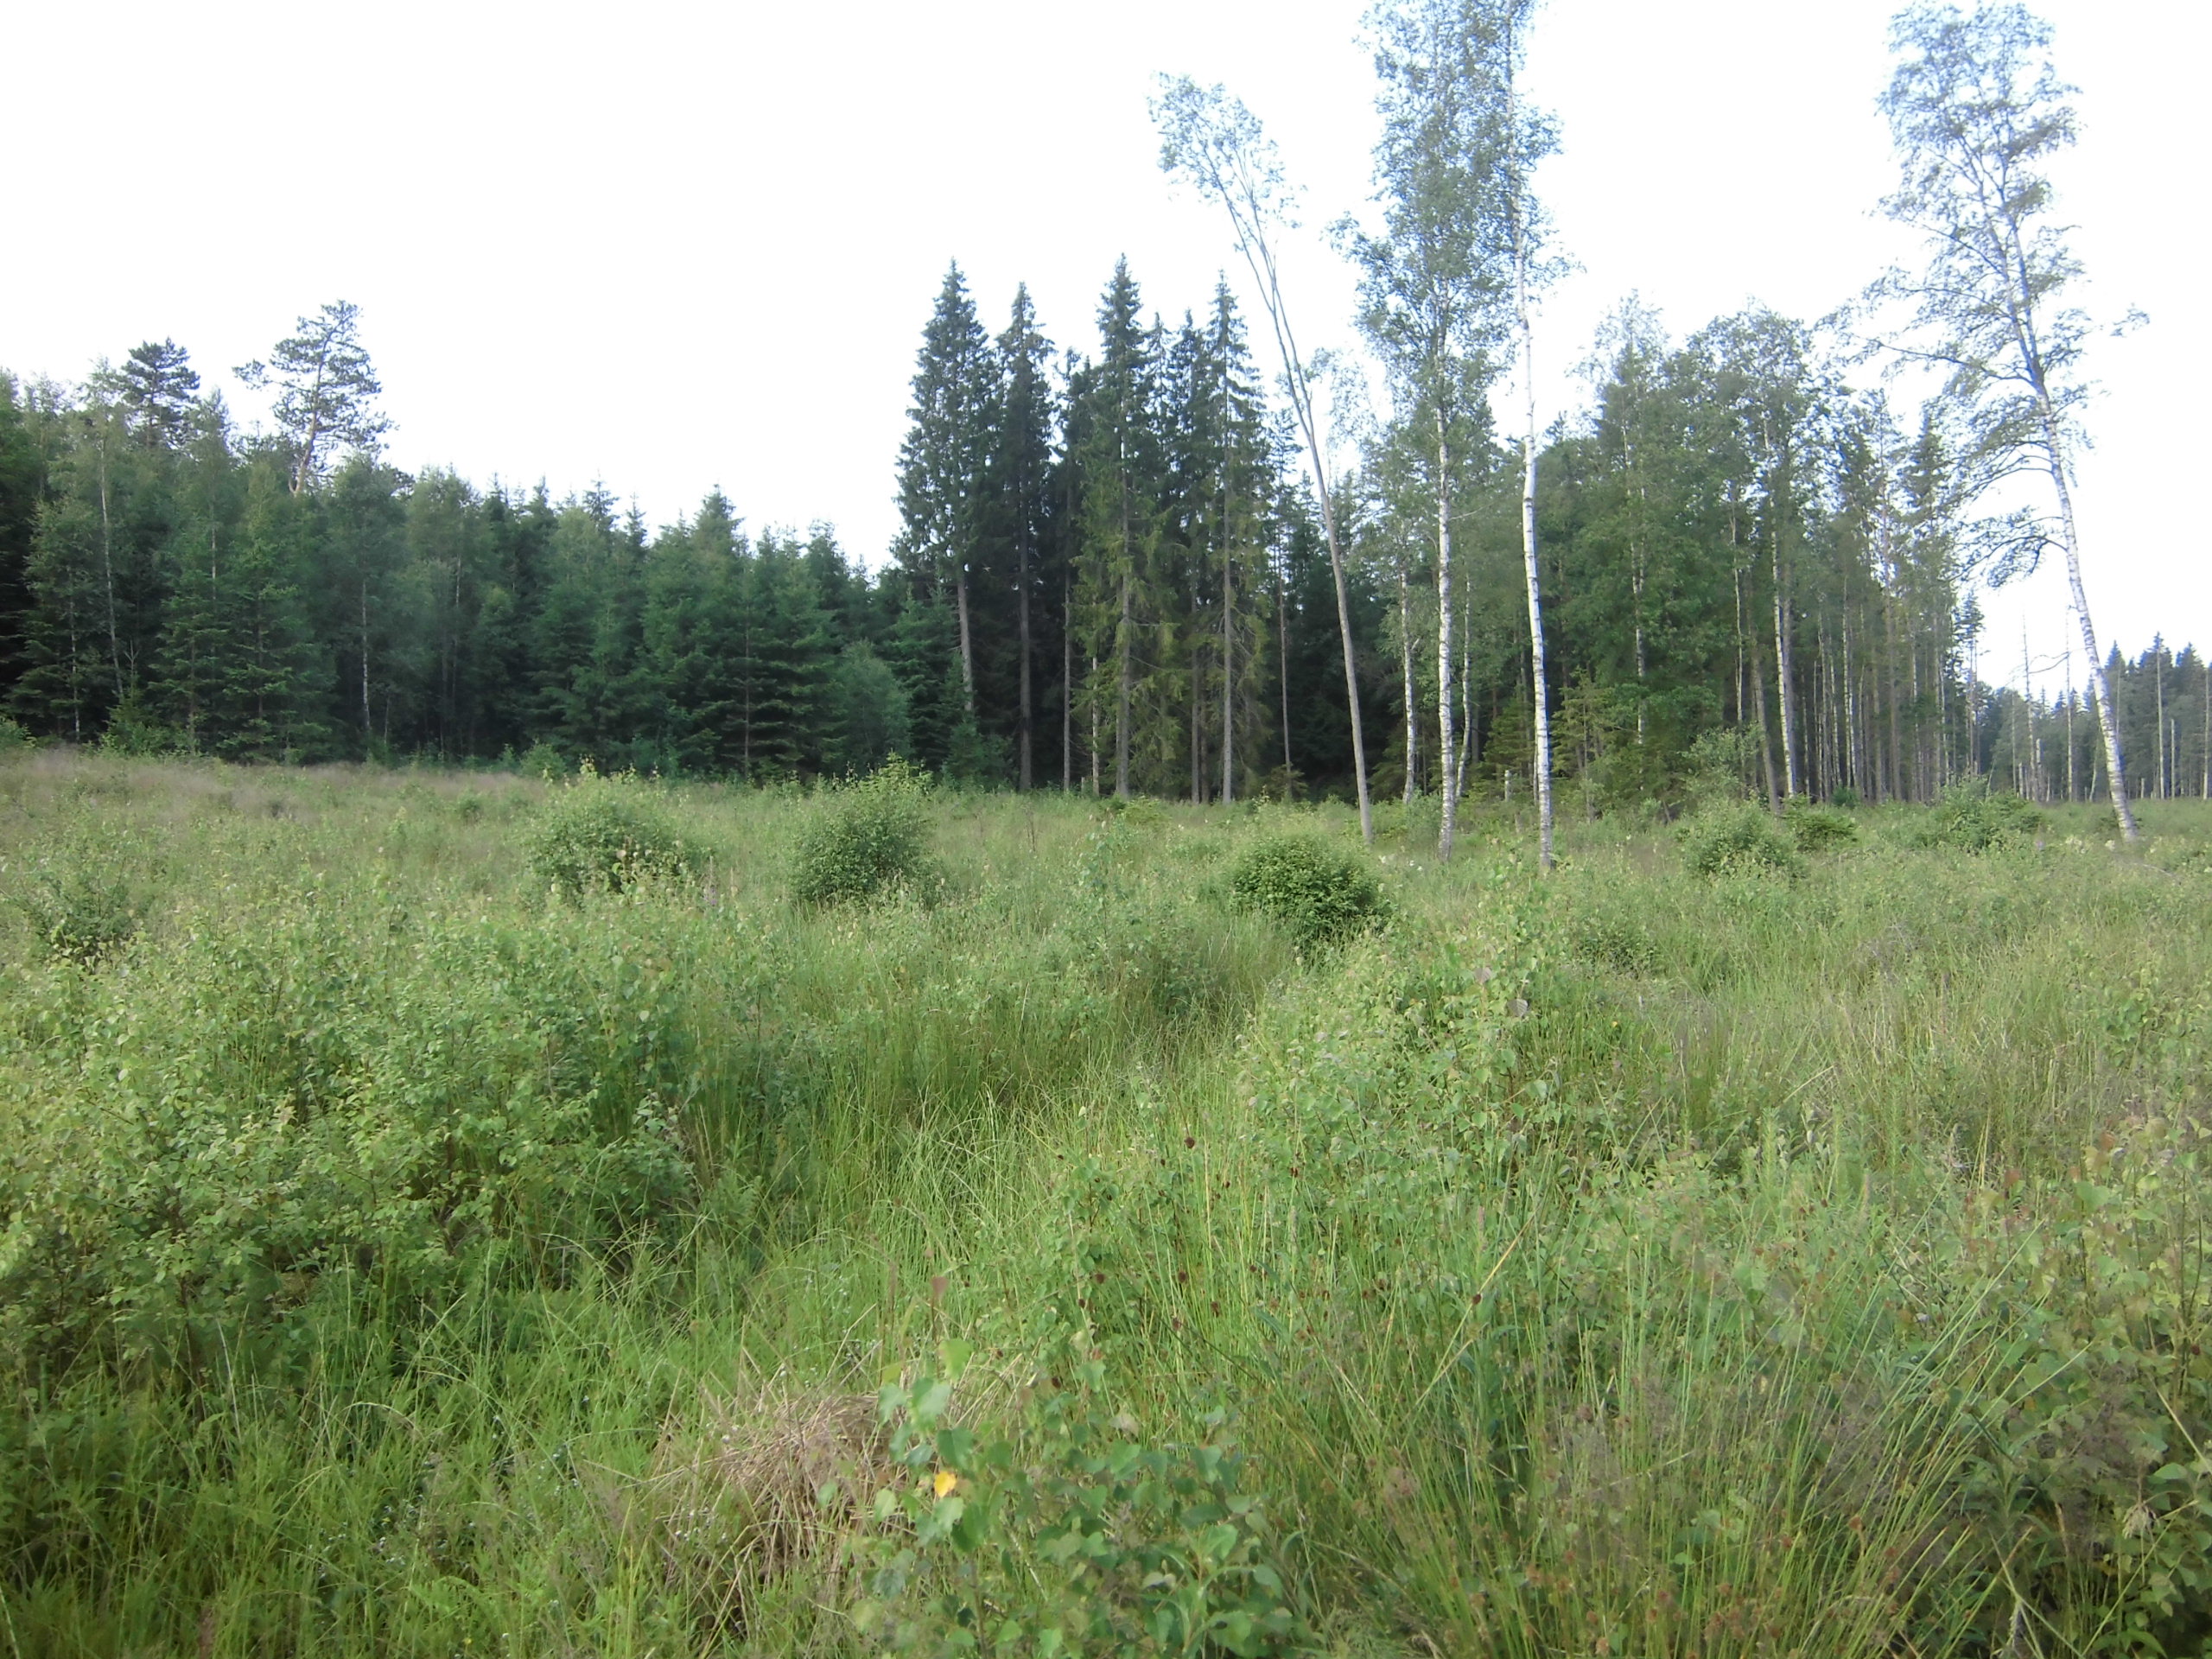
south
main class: Woodland
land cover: Pine dominated mixed woodland
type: boreal forest
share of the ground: 25 - 50 %
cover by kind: herbaceous plants 40 %, shrubs 25 %, broadleaved forest trees 15 %, coniferous forest trees 10 %, lichens and mosses 10 %
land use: Forestry
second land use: Amenities, museums, leisure
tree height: > 5 m
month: July
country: SE
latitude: 57.3937
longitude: 14.8380
